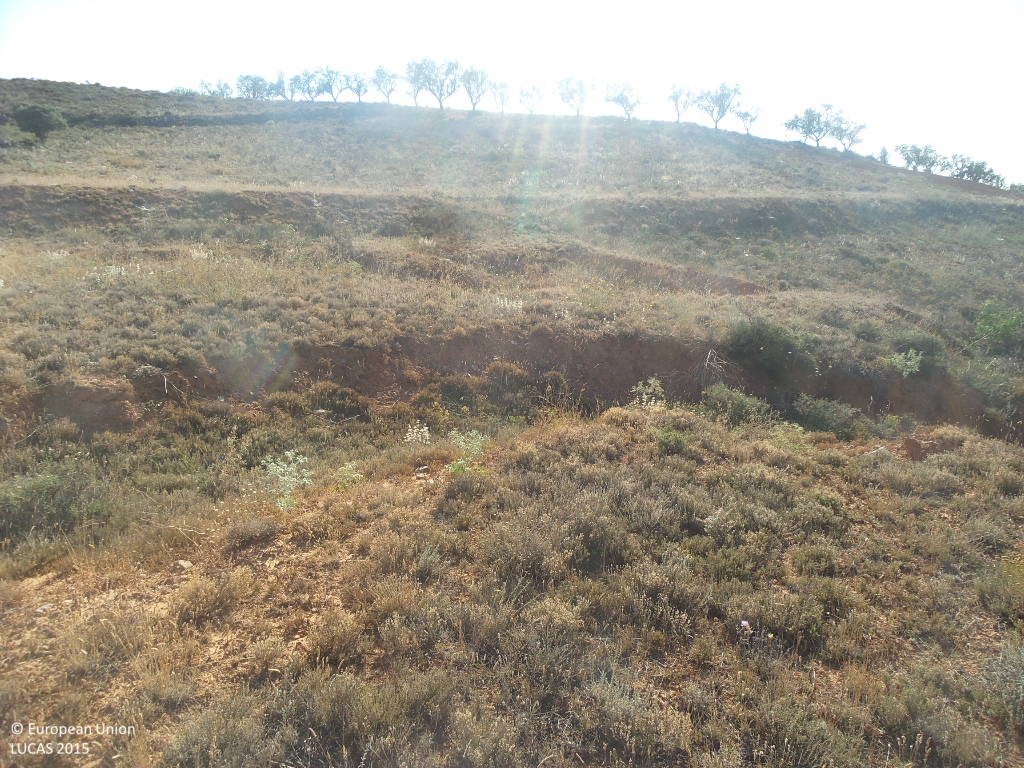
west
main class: Shrubland
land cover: Shrubland without tree cover
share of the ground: 50 - 75 %
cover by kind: shrubs 60 %, unconsolidated bare surface 30 %, herbaceous plants 10 %
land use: Semi-natural and natural areas not in use
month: July
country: ES
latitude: 41.2743
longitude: -1.9053
